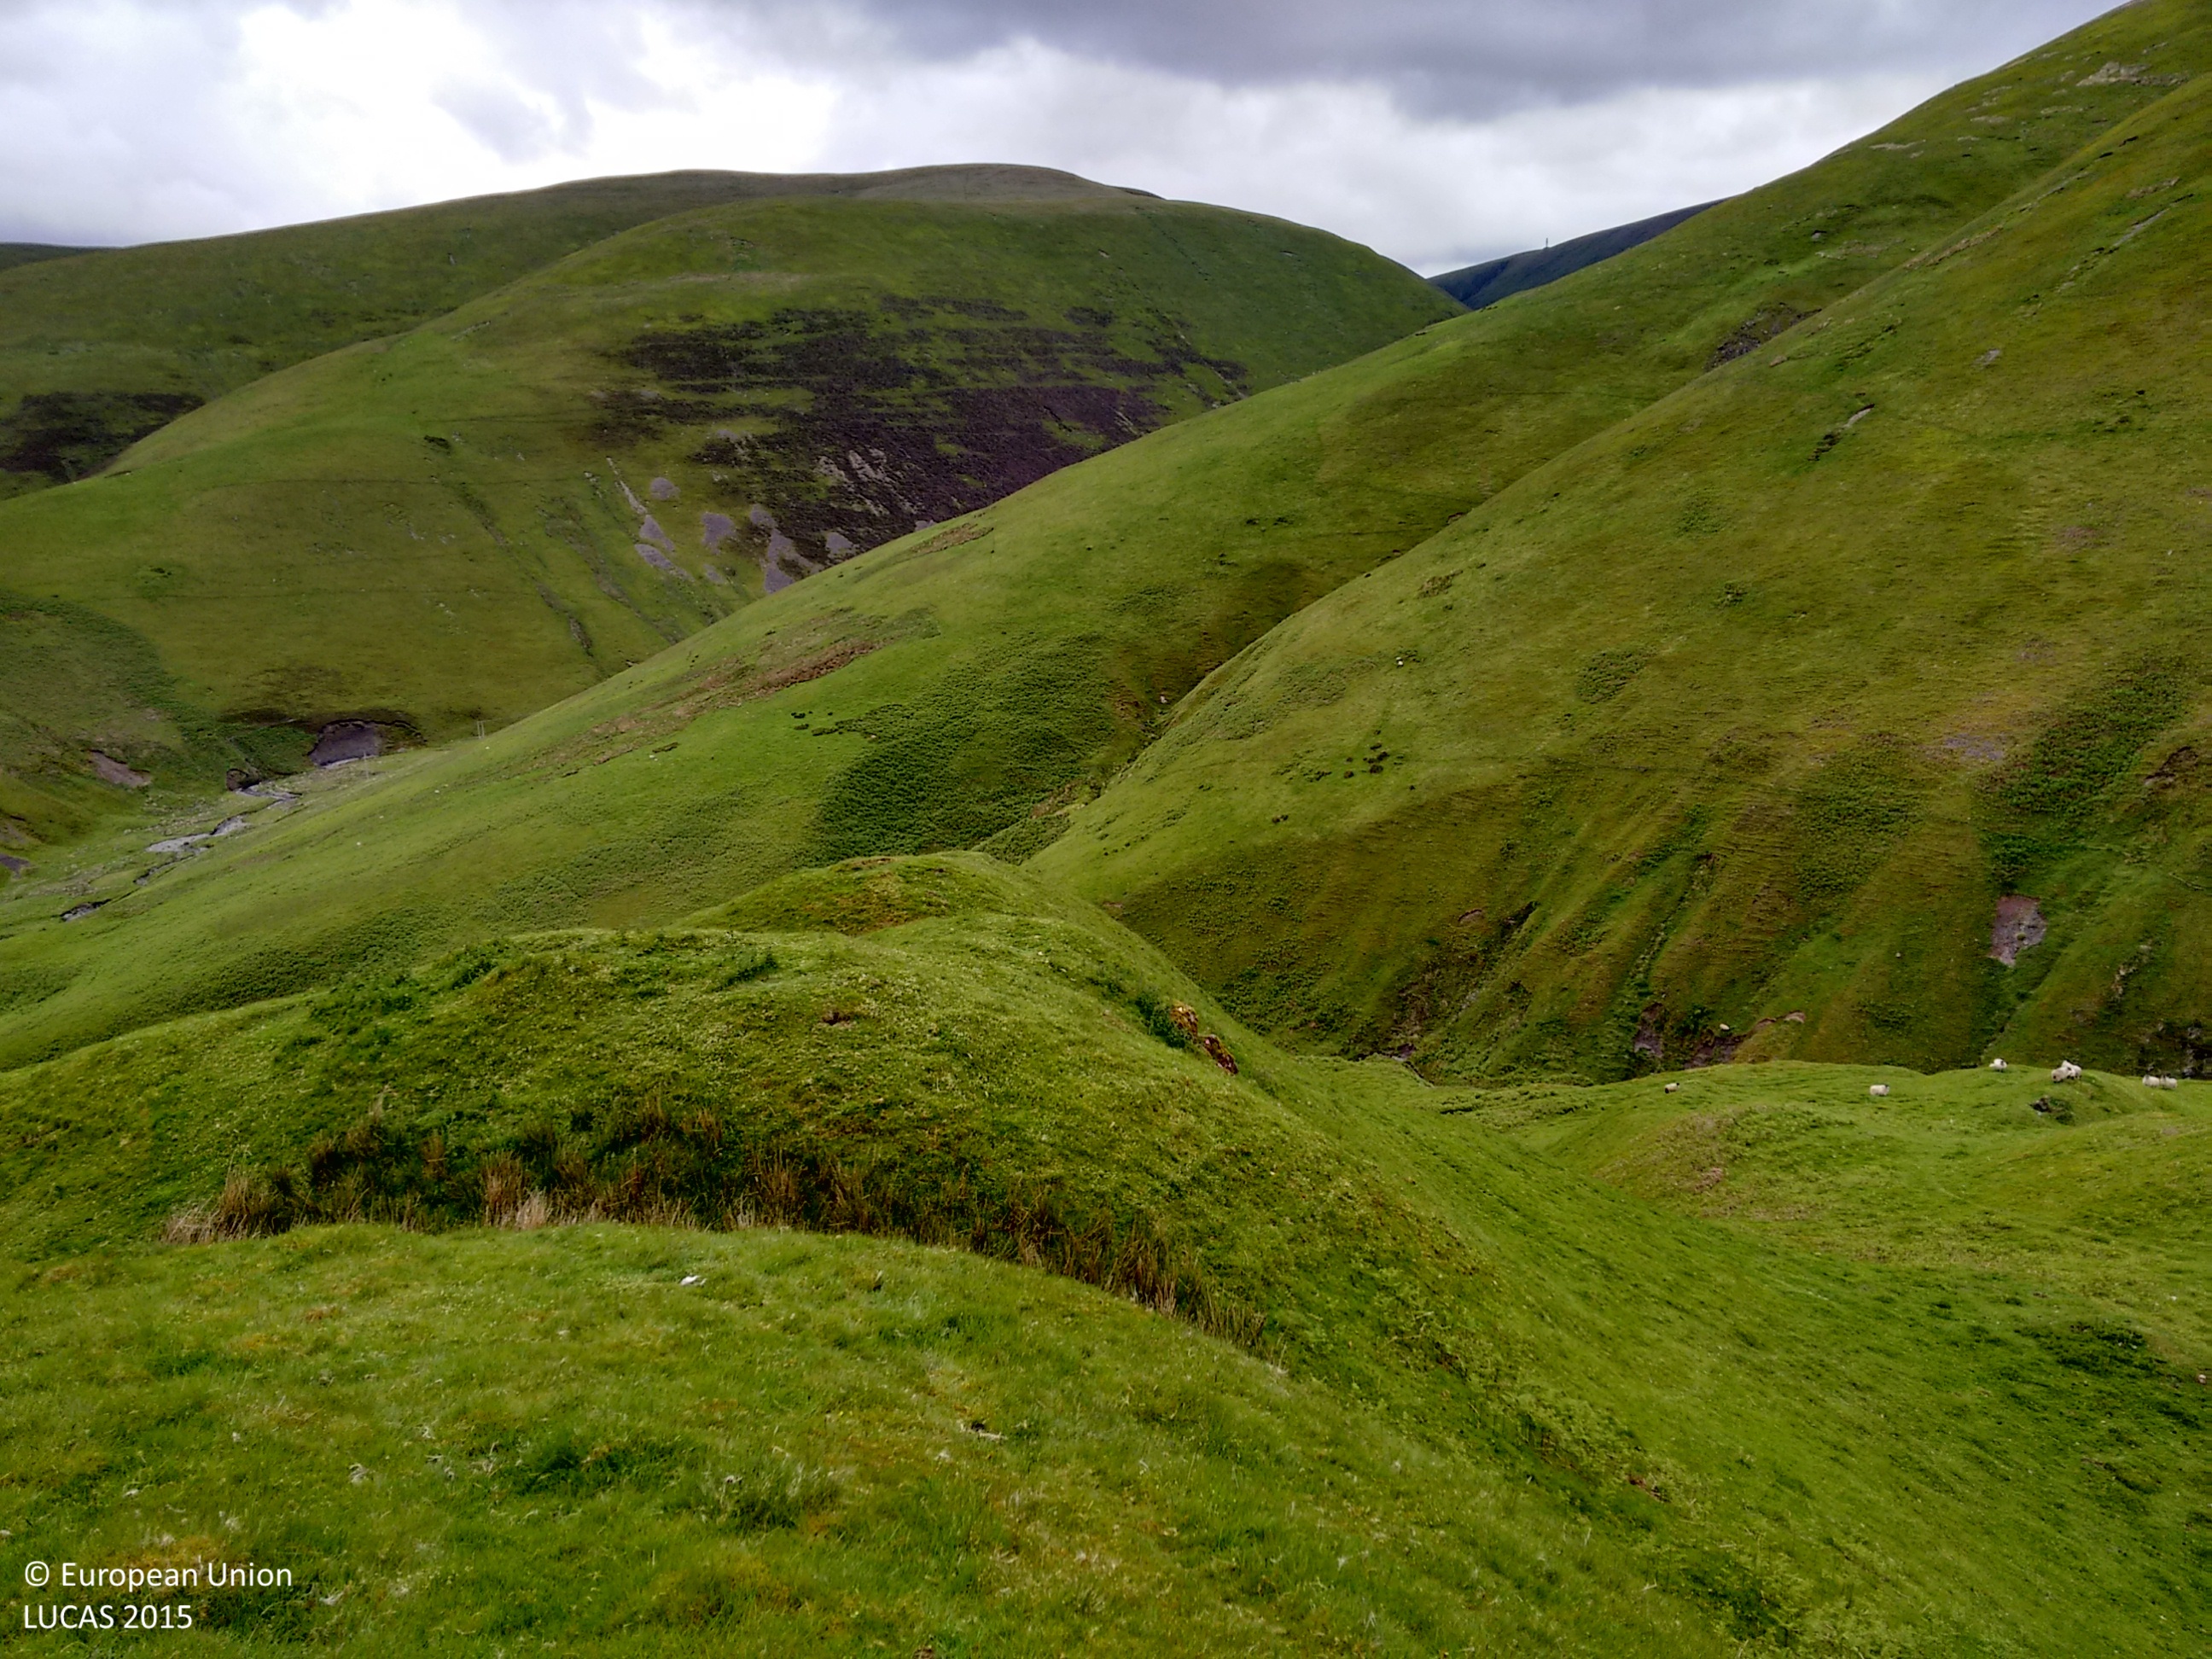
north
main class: Grassland
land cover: Grassland without tree/shrub cover
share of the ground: > 75 %
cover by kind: herbaceous plants 100 %
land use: Agriculture (excluding fallow land and kitchen gardens)
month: June
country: GB
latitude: 55.3505
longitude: -3.7581
